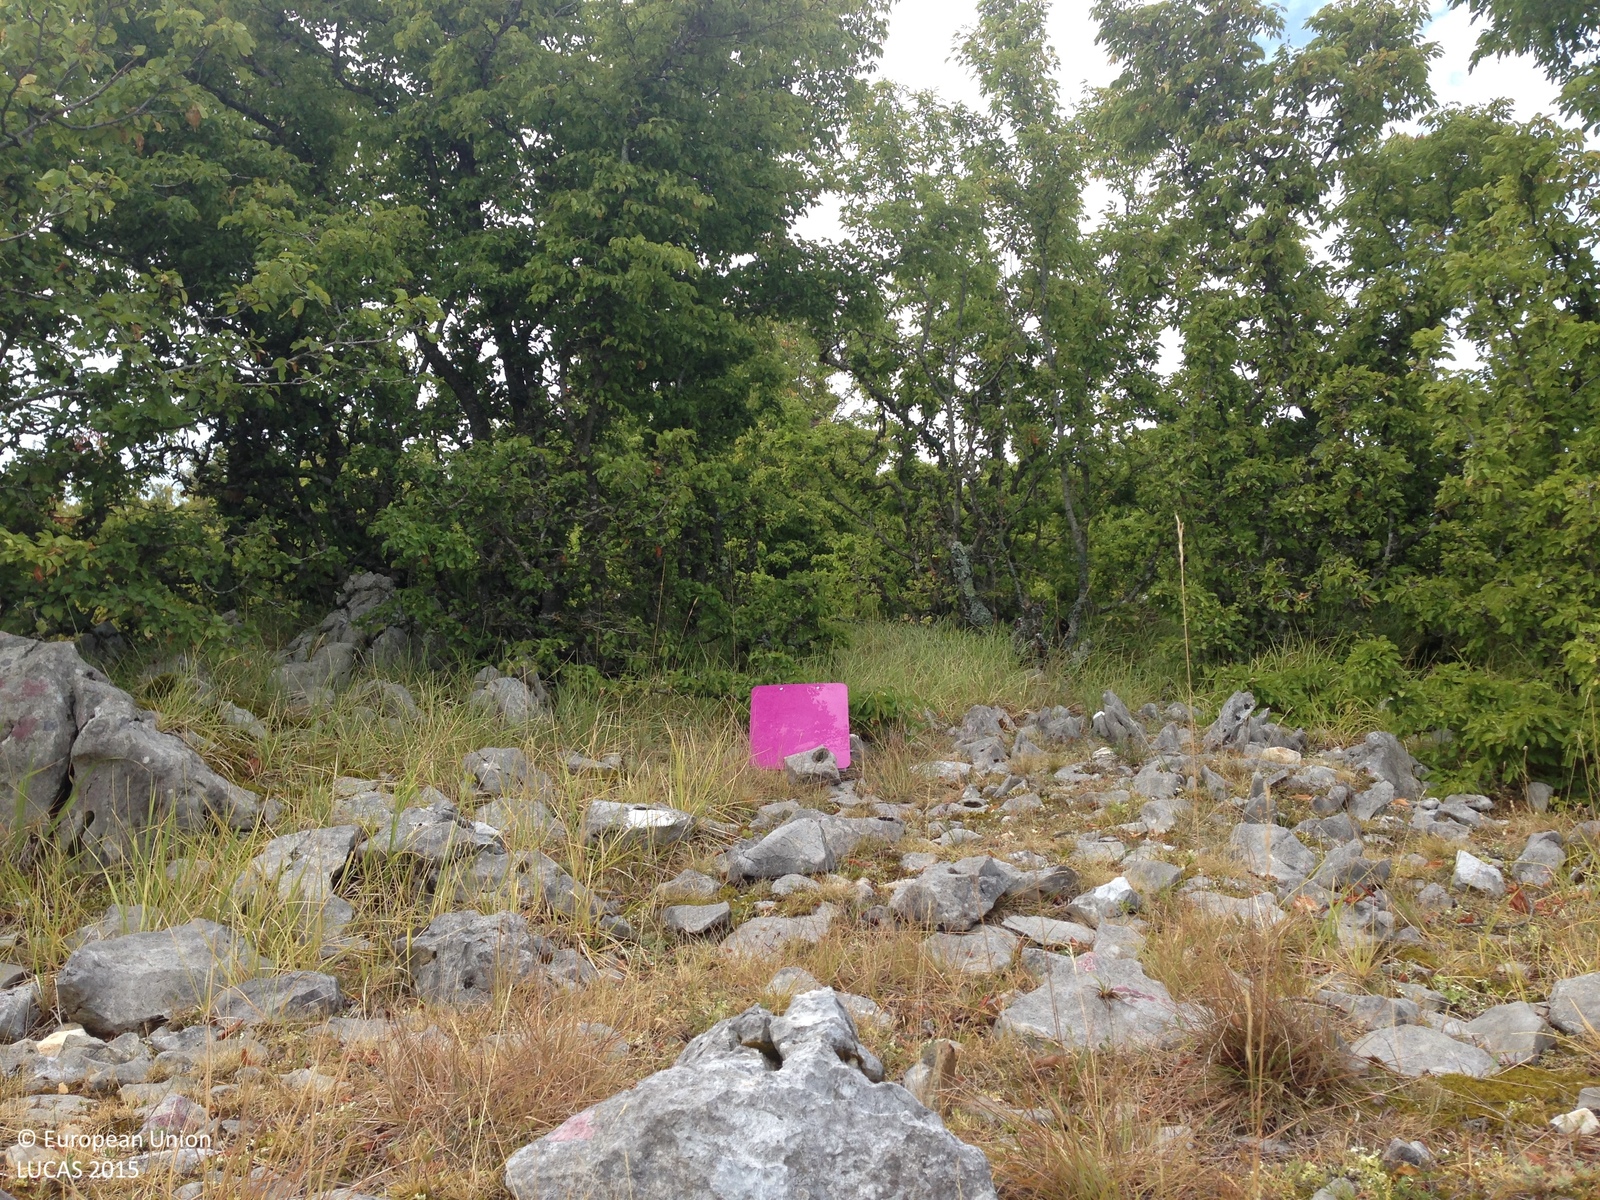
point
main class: Woodland
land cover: Broadleaved woodland
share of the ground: 50 - 75 %
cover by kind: broadleaved forest trees 55 %, unconsolidated bare surface 15 %, shrubs 10 %, herbaceous plants 10 %, consolidated bare surface 10 %
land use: Semi-natural and natural areas not in use
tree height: < 5 m
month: July
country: HR
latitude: 44.1490
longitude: 15.8560
